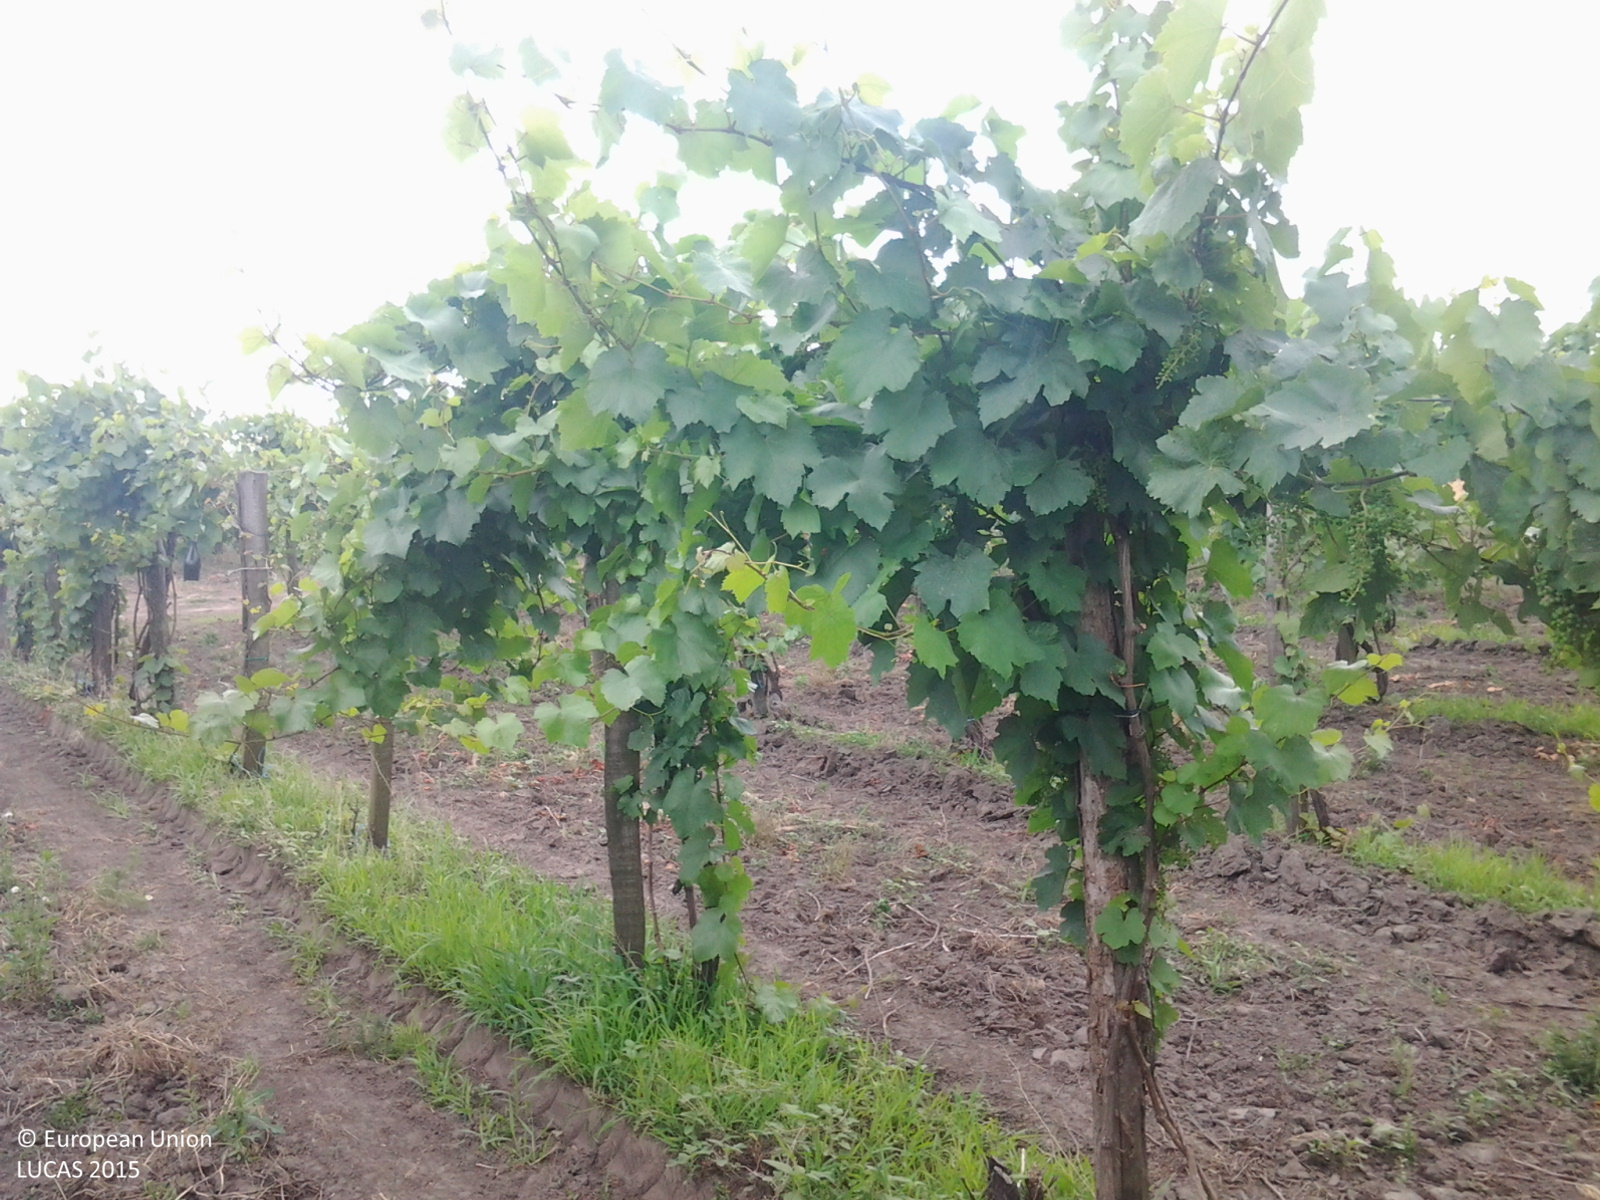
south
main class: Cropland
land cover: Vineyards
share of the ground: 25 - 50 %
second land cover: Other bare soil
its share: > 75 %
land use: Agriculture (excluding fallow land and kitchen gardens)
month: June
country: HU
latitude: 46.4037
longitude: 19.0275
